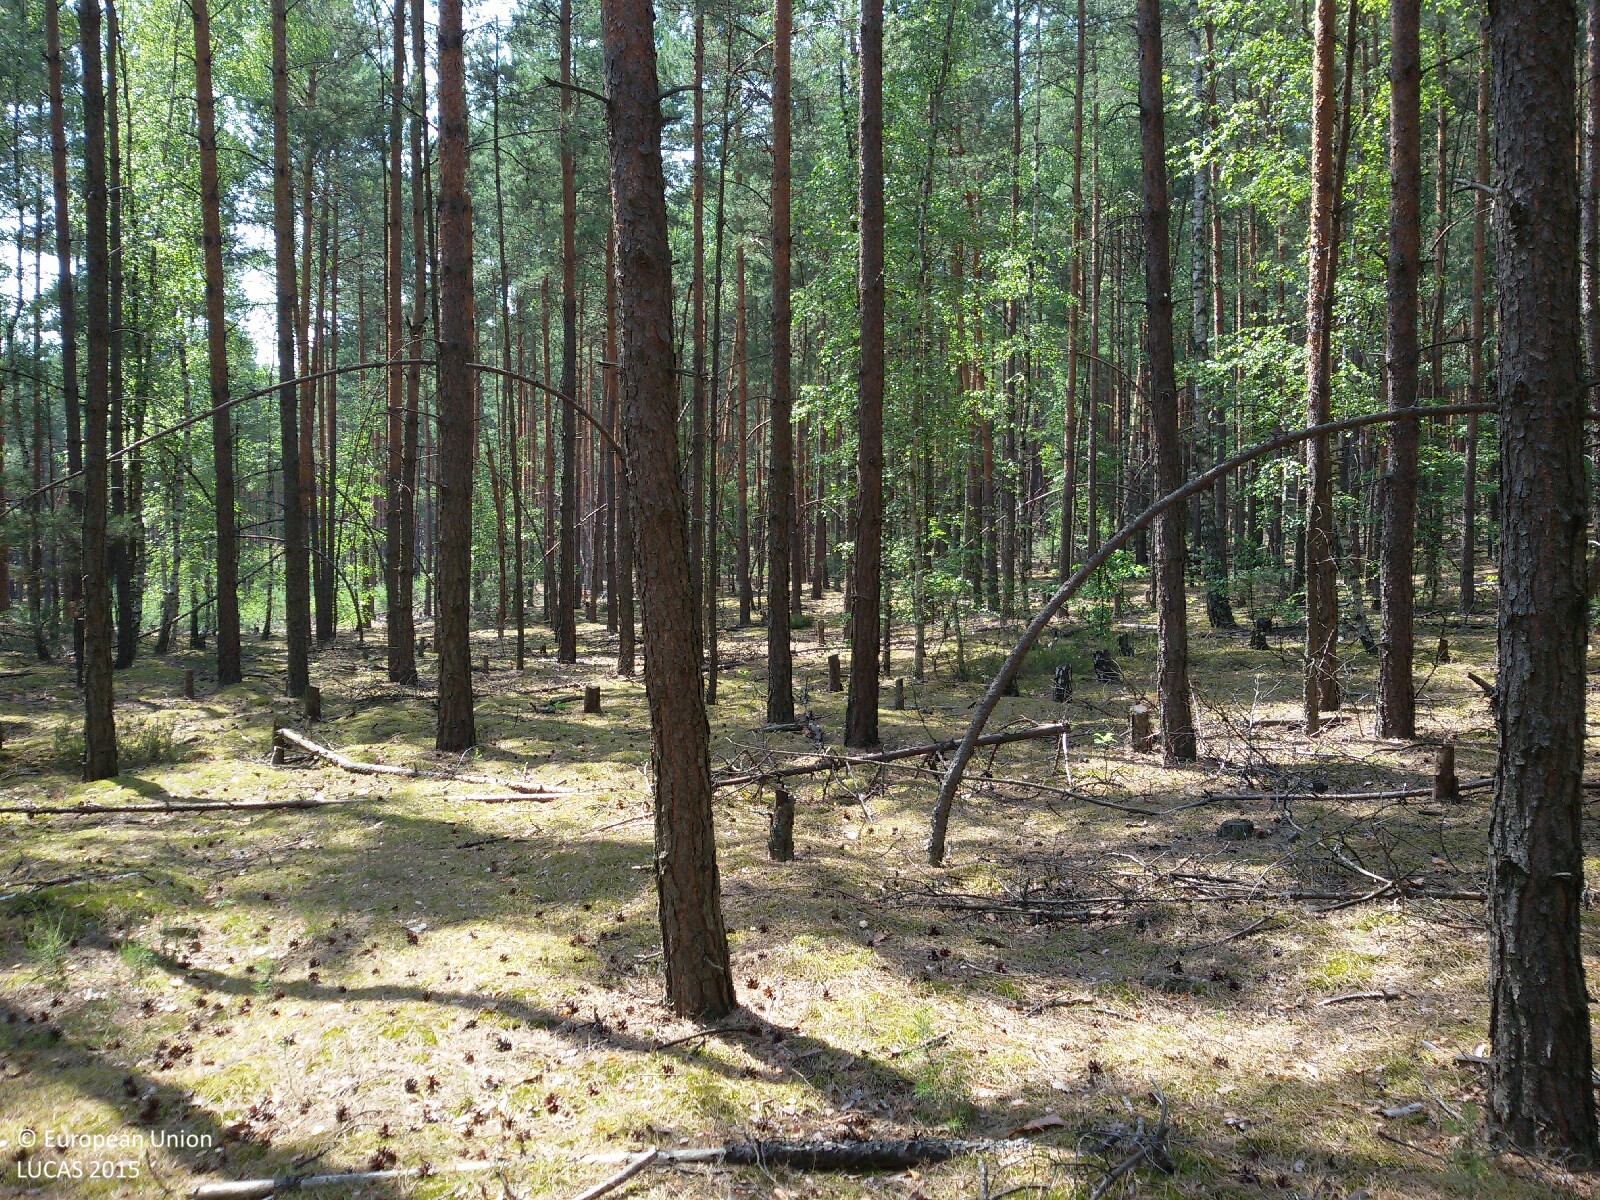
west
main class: Woodland
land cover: Pine dominated coniferous woodland
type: hemiboreal forest and nemoral coniferous forest and mixed broadleaved-coniferous forest
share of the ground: > 75 %
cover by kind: coniferous forest trees 75 %, herbaceous plants 20 %, lichens and mosses 5 %
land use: Forestry
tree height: > 5 m
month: July
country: PL
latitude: 52.1488
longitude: 21.2570
